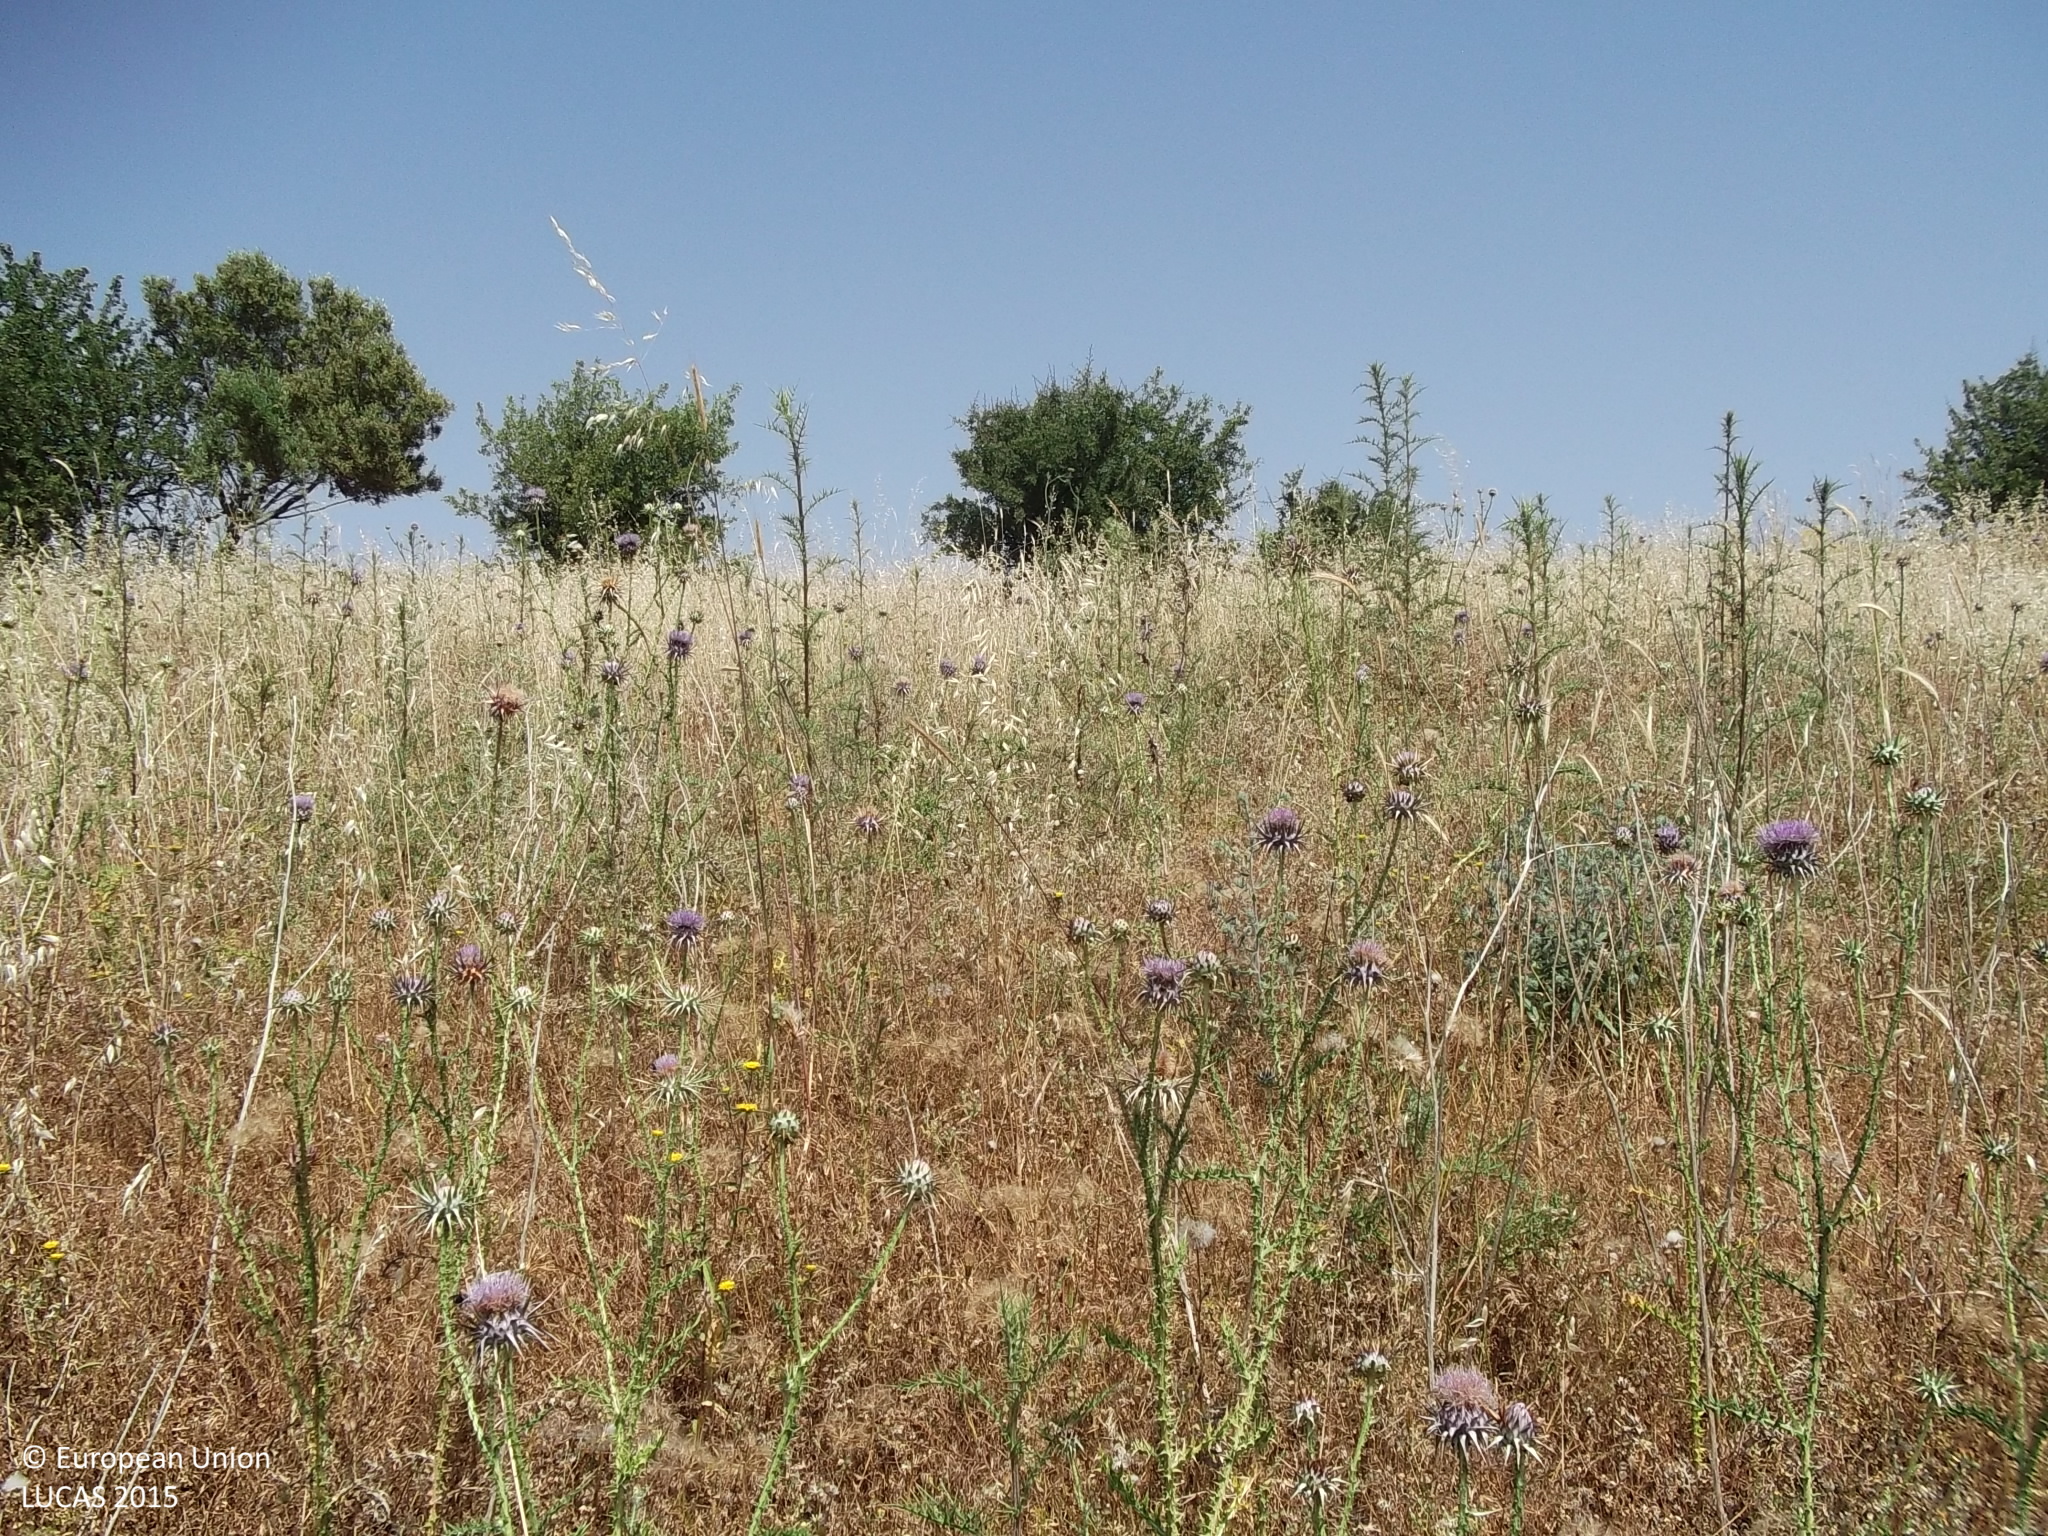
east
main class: Grassland
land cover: Grassland with sparse tree/shrub cover
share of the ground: > 75 %
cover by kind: herbaceous plants 95 %, broadleaved forest trees 5 %
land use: Semi-natural and natural areas not in use
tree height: < 5 m
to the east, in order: Grassland with sparse tree/shrub cover; Mixed cereals for fodder; Tracks; Spontaneously vegetated surfaces; Grassland with sparse tree/shrub cover; Broadleaved woodland; Grassland with sparse tree/shrub cover; Tracks; Broadleaved woodland
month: May
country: CY
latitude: 34.8141
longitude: 32.5505
